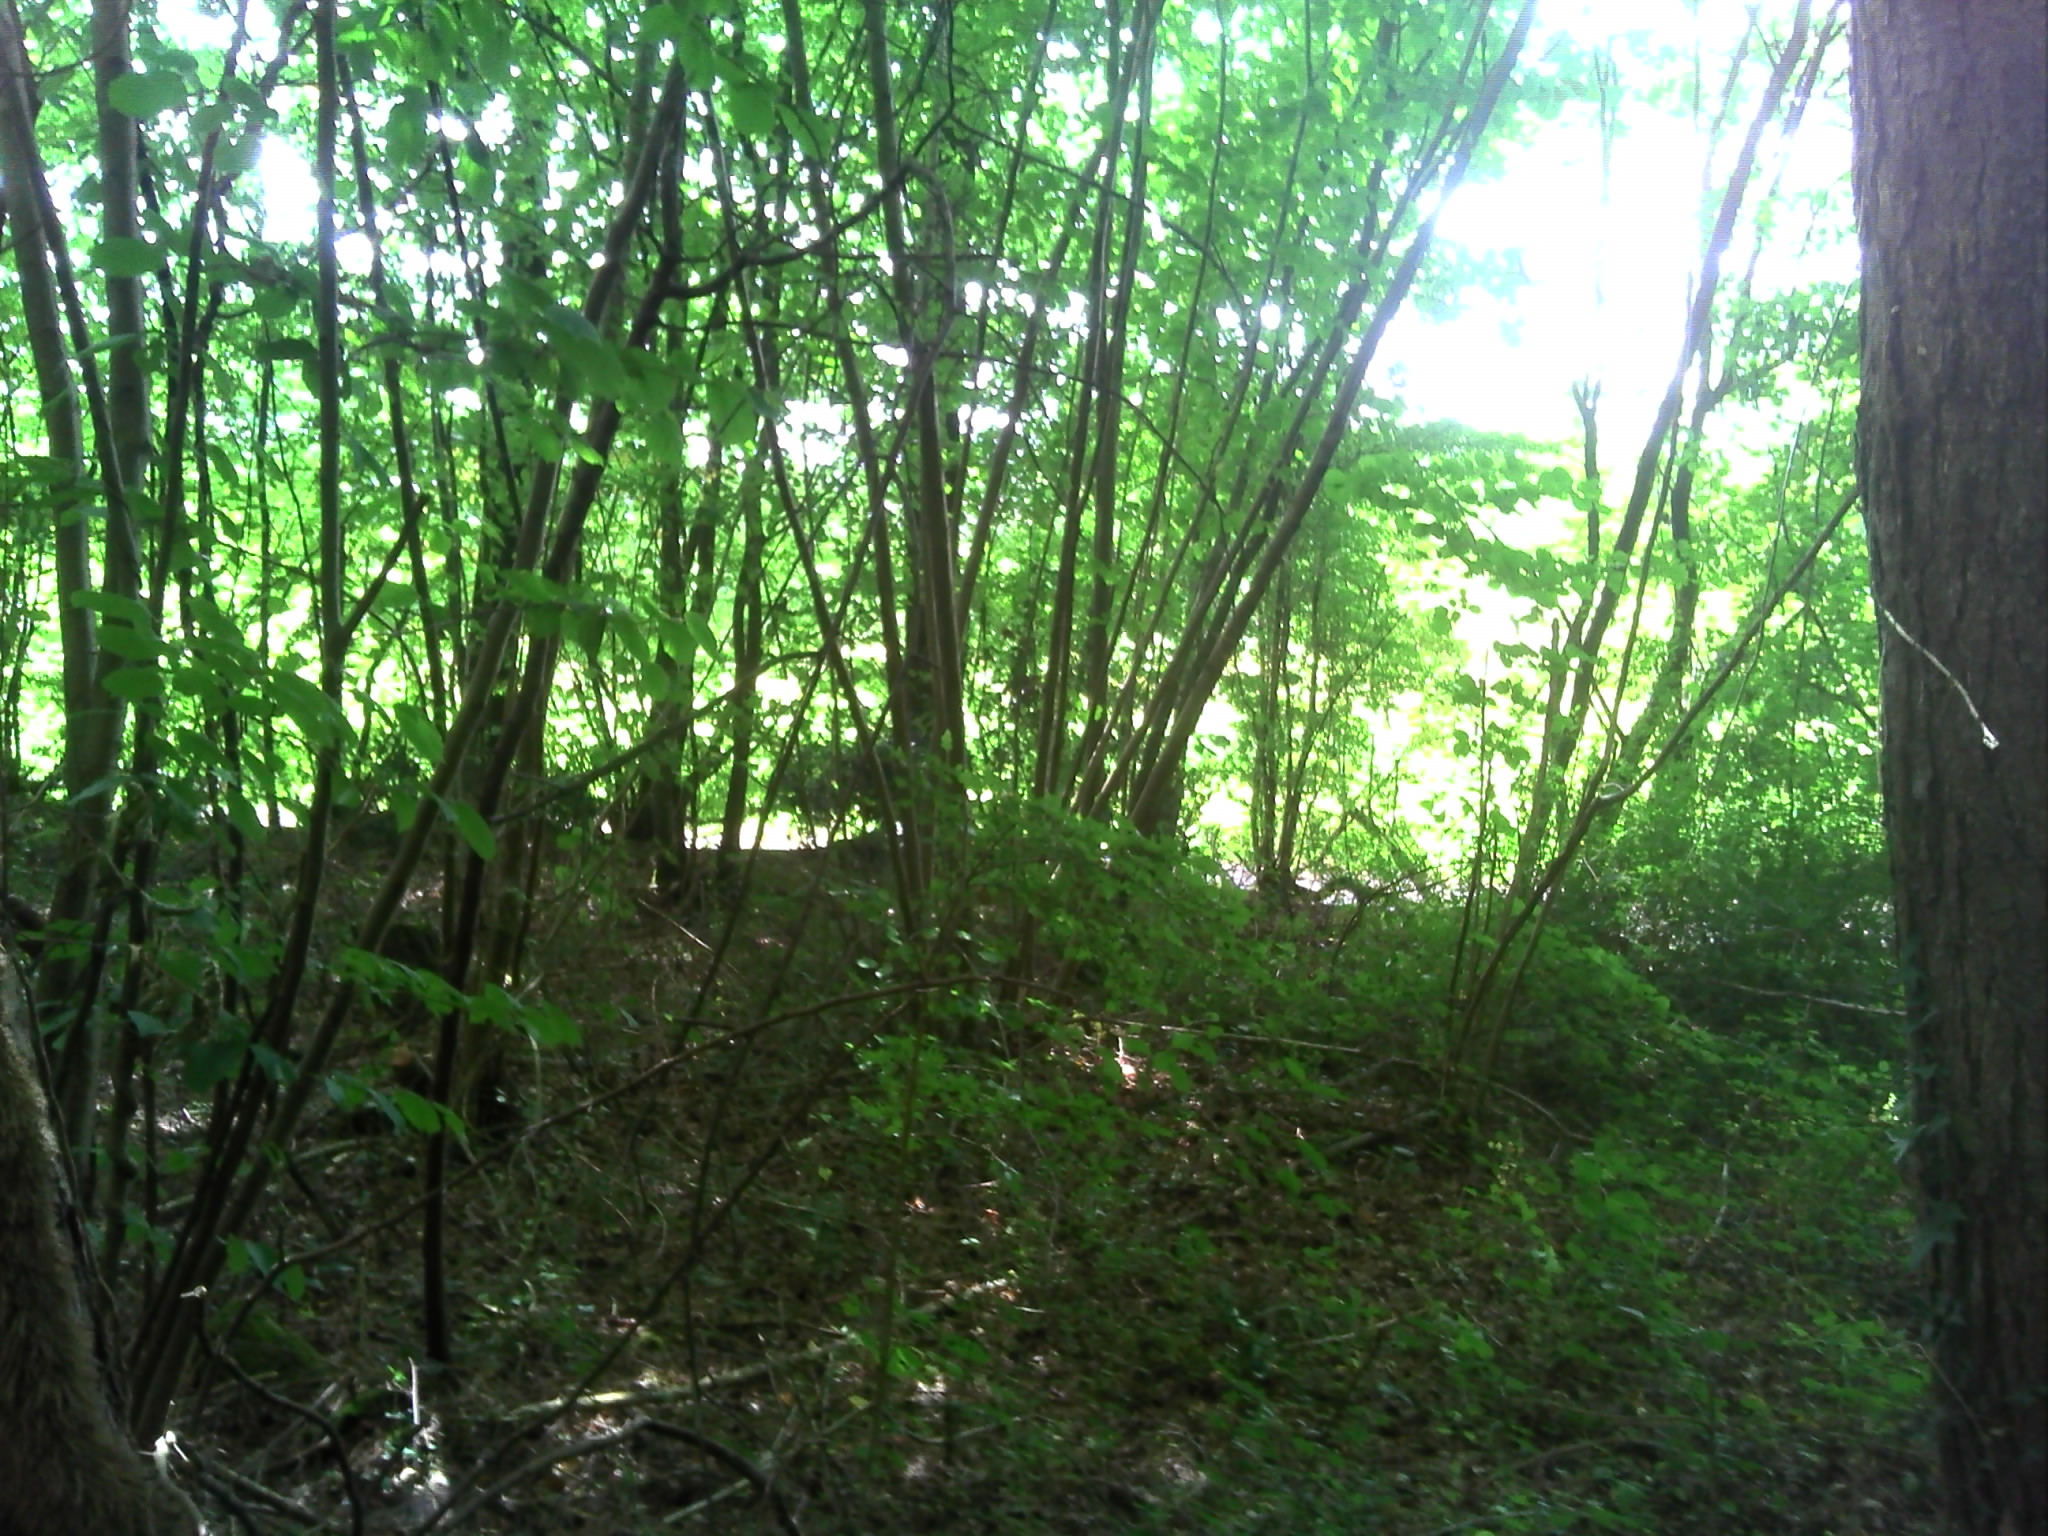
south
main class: Woodland
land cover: Broadleaved woodland
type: mesophytic deciduous forest
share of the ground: > 75 %
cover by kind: broadleaved forest trees 95 %, coniferous forest trees 5 %
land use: Forestry
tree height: > 5 m
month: August
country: FR
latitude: 46.7794
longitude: -1.3669
